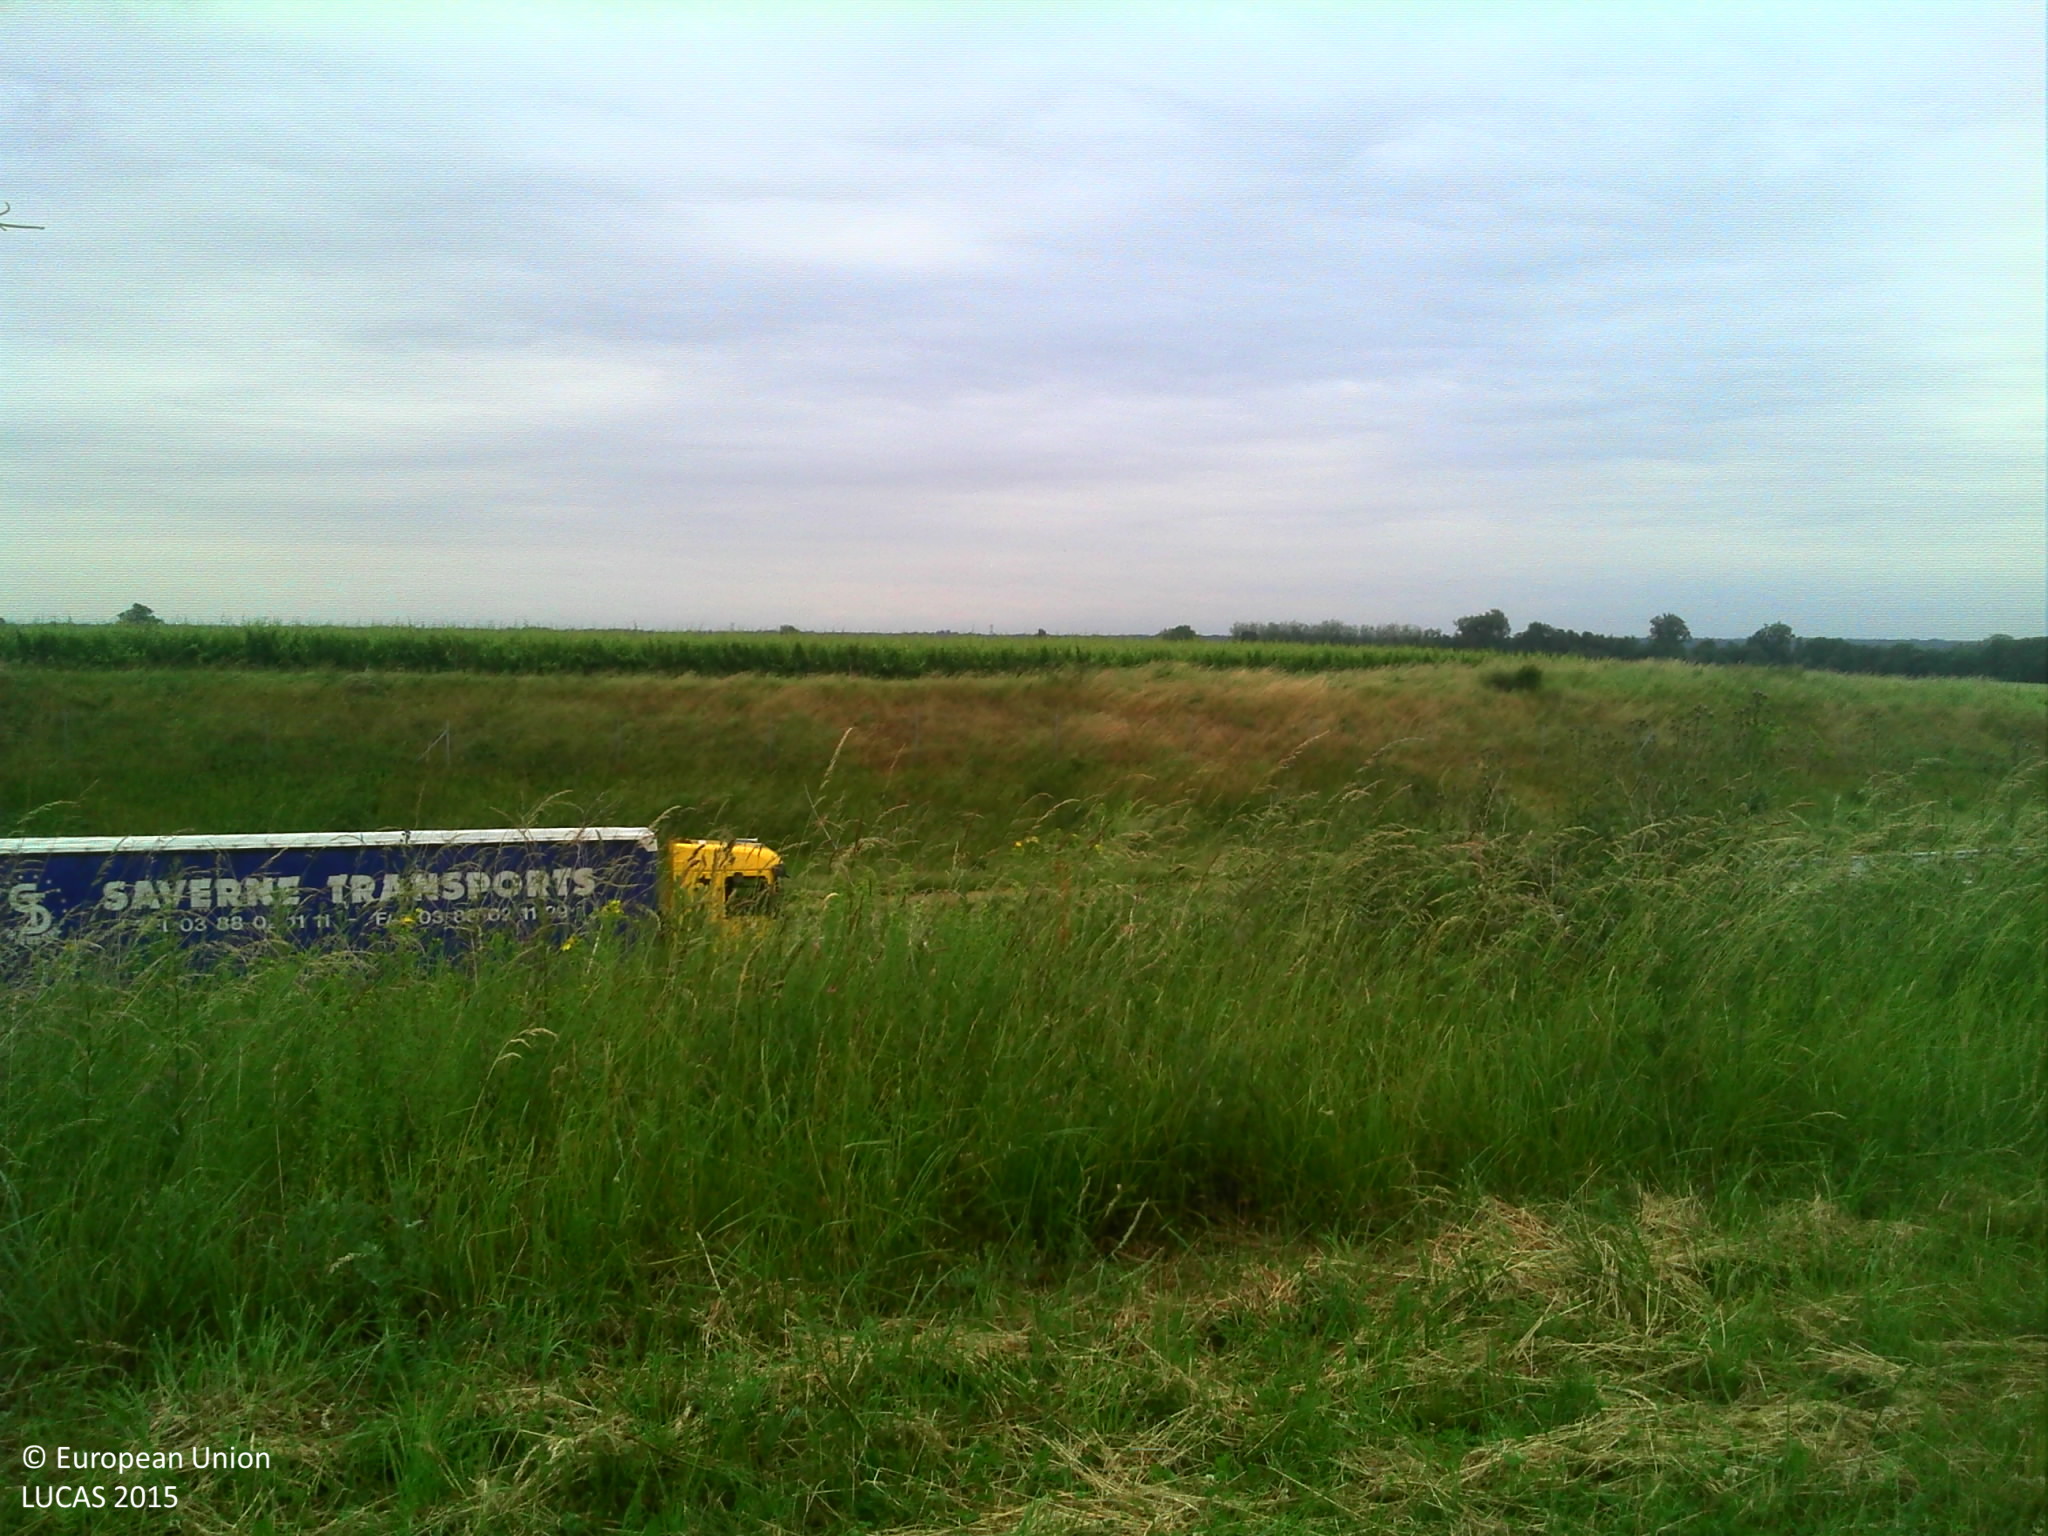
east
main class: Cropland
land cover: Vineyards
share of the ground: 50 - 75 %
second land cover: Grassland without tree/shrub cover
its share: 50 - 75 %
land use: Agriculture (excluding fallow land and kitchen gardens)
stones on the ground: < 10 %
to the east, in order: Vineyards; Grassland without tree/shrub cover; Grass margins; Spontaneously vegetated surfaces; Fences; Paved roads, cycling and walking lanes; Fences; Grassland without tree/shrub cover
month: June
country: FR
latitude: 48.3927
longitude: 7.4754
